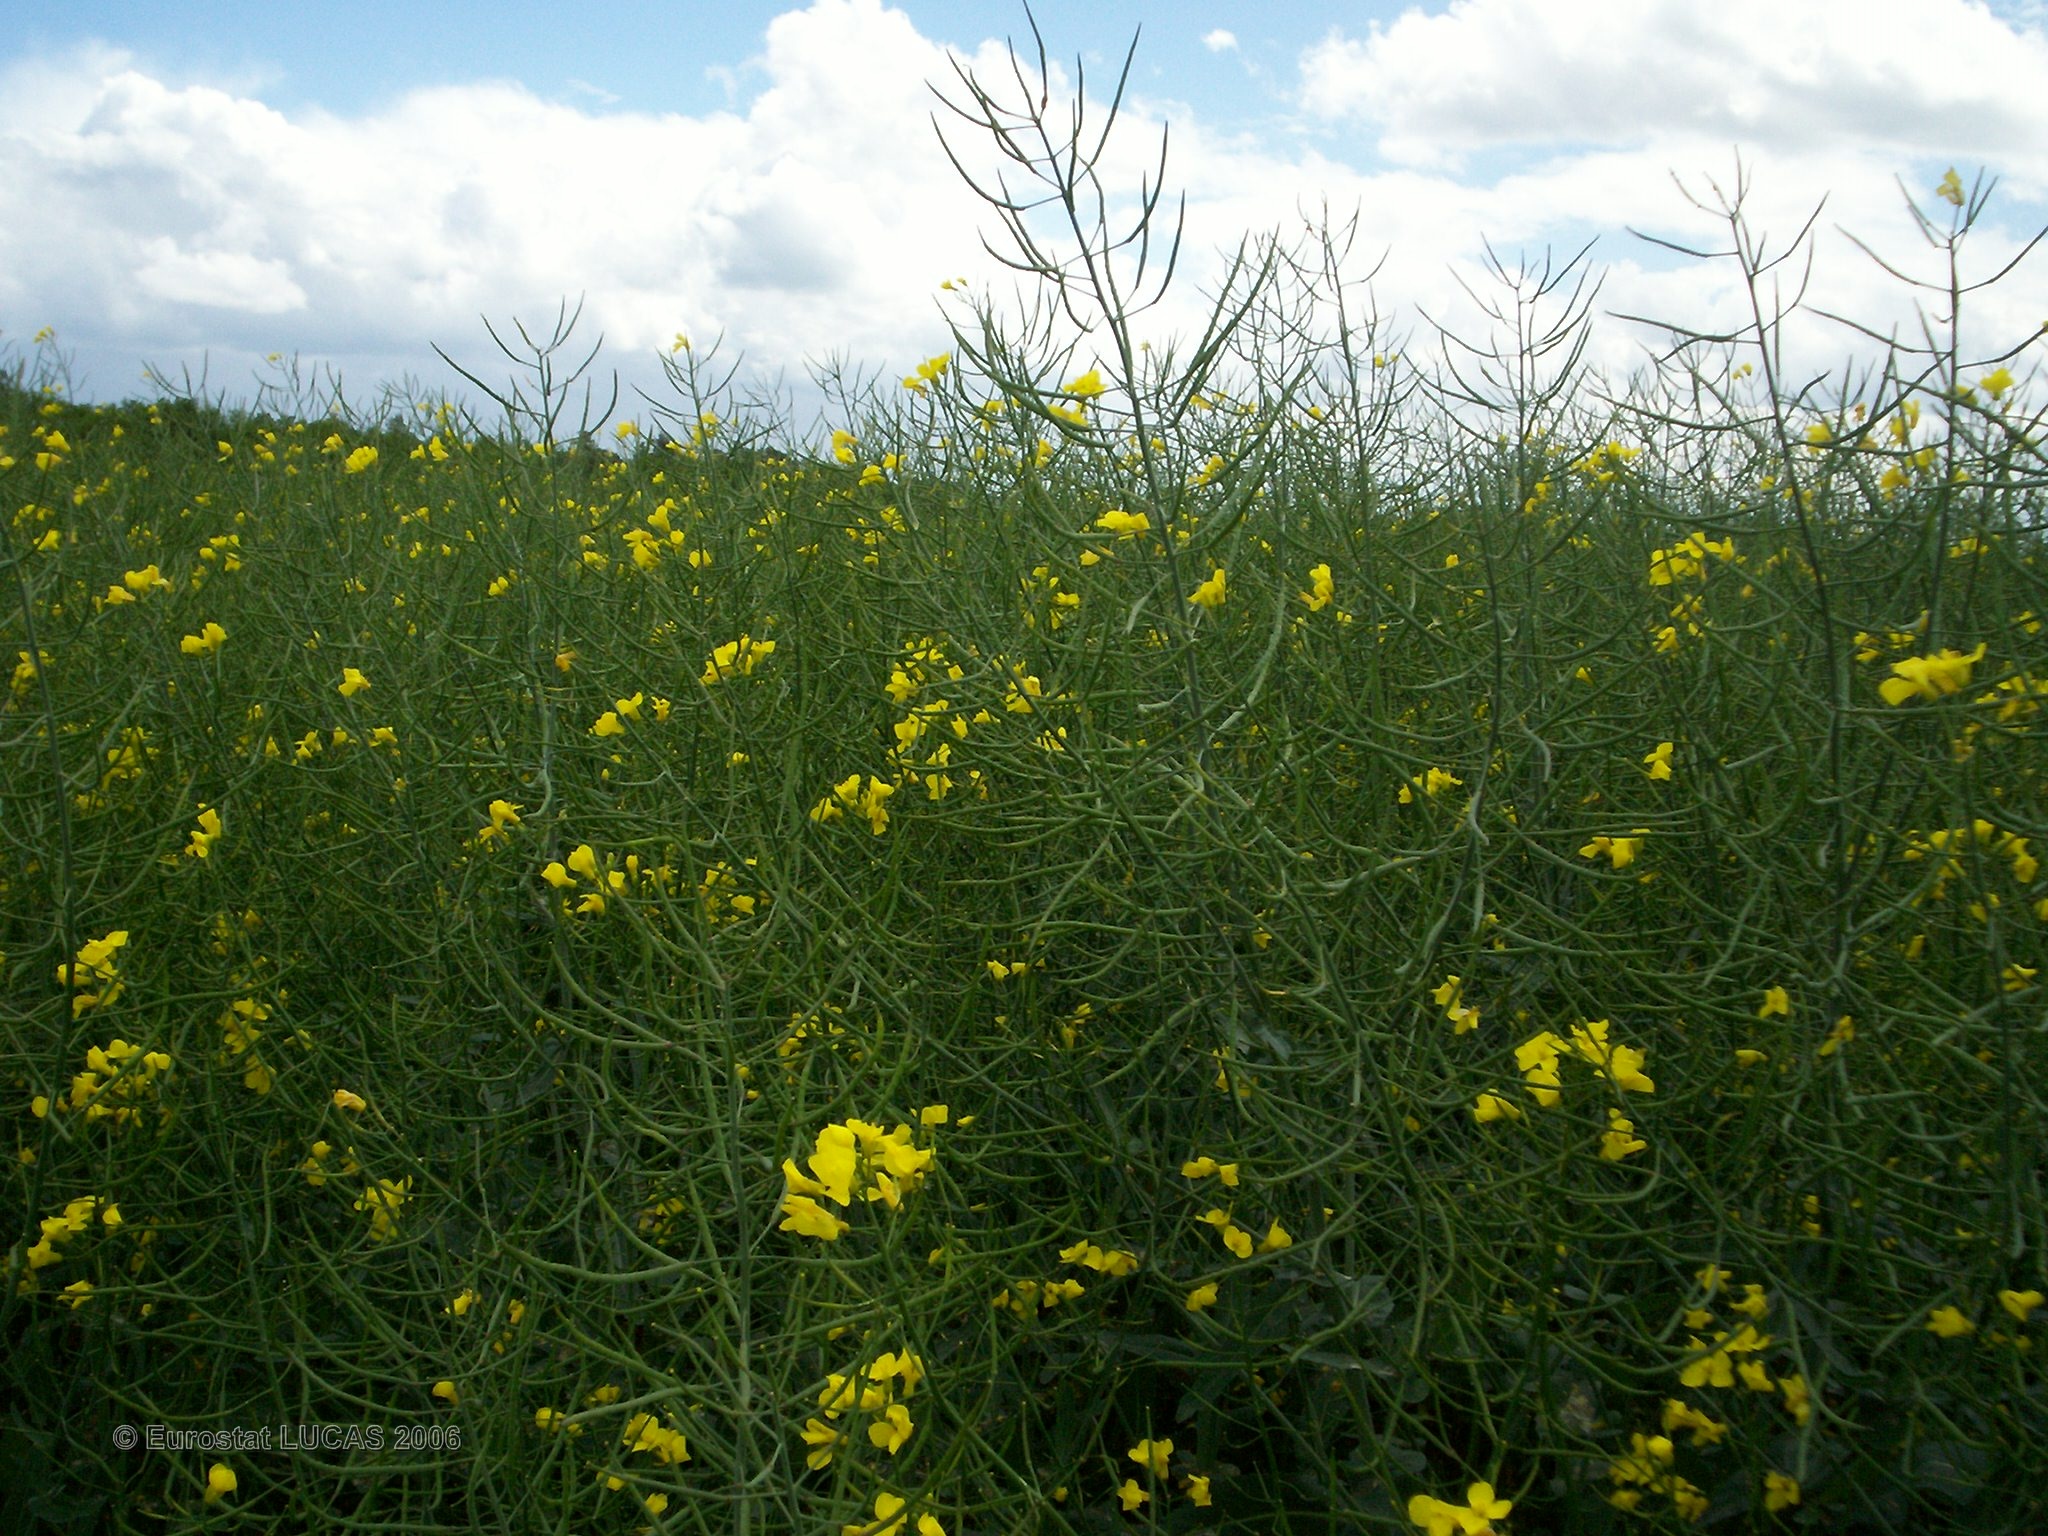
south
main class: Cropland
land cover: Rape and turnip rape
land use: Agriculture (excluding fallow land and kitchen gardens)
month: May
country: FR
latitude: 47.7567
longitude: 4.0610
